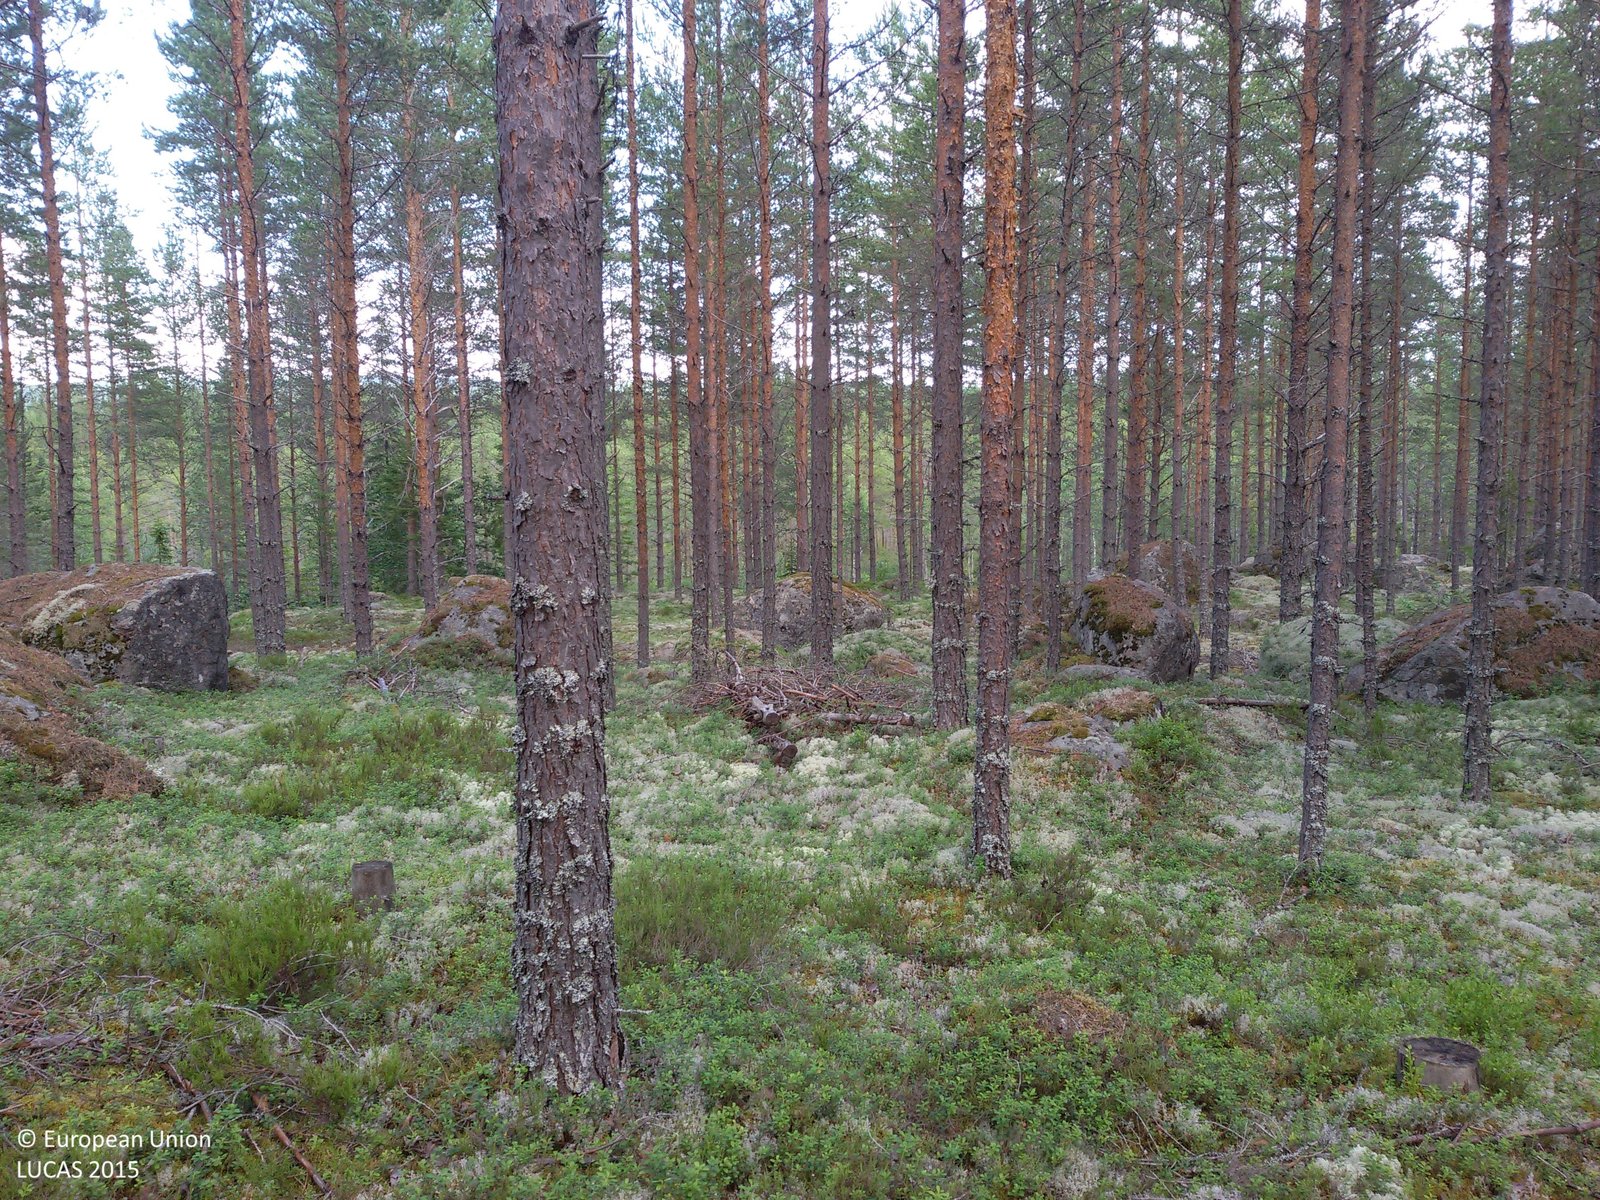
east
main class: Woodland
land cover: Pine dominated coniferous woodland
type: boreal forest
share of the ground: 50 - 75 %
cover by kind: coniferous forest trees 70 %, herbaceous plants 15 %, lichens and mosses 15 %
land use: Forestry
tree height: > 5 m
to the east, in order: Pine dominated coniferous woodland; Ditches and canals; Pine dominated coniferous woodland; Spruce dominated mixed woodland; Tracks; Spruce dominated mixed woodland
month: July
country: SE
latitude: 60.3482
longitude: 14.8991
